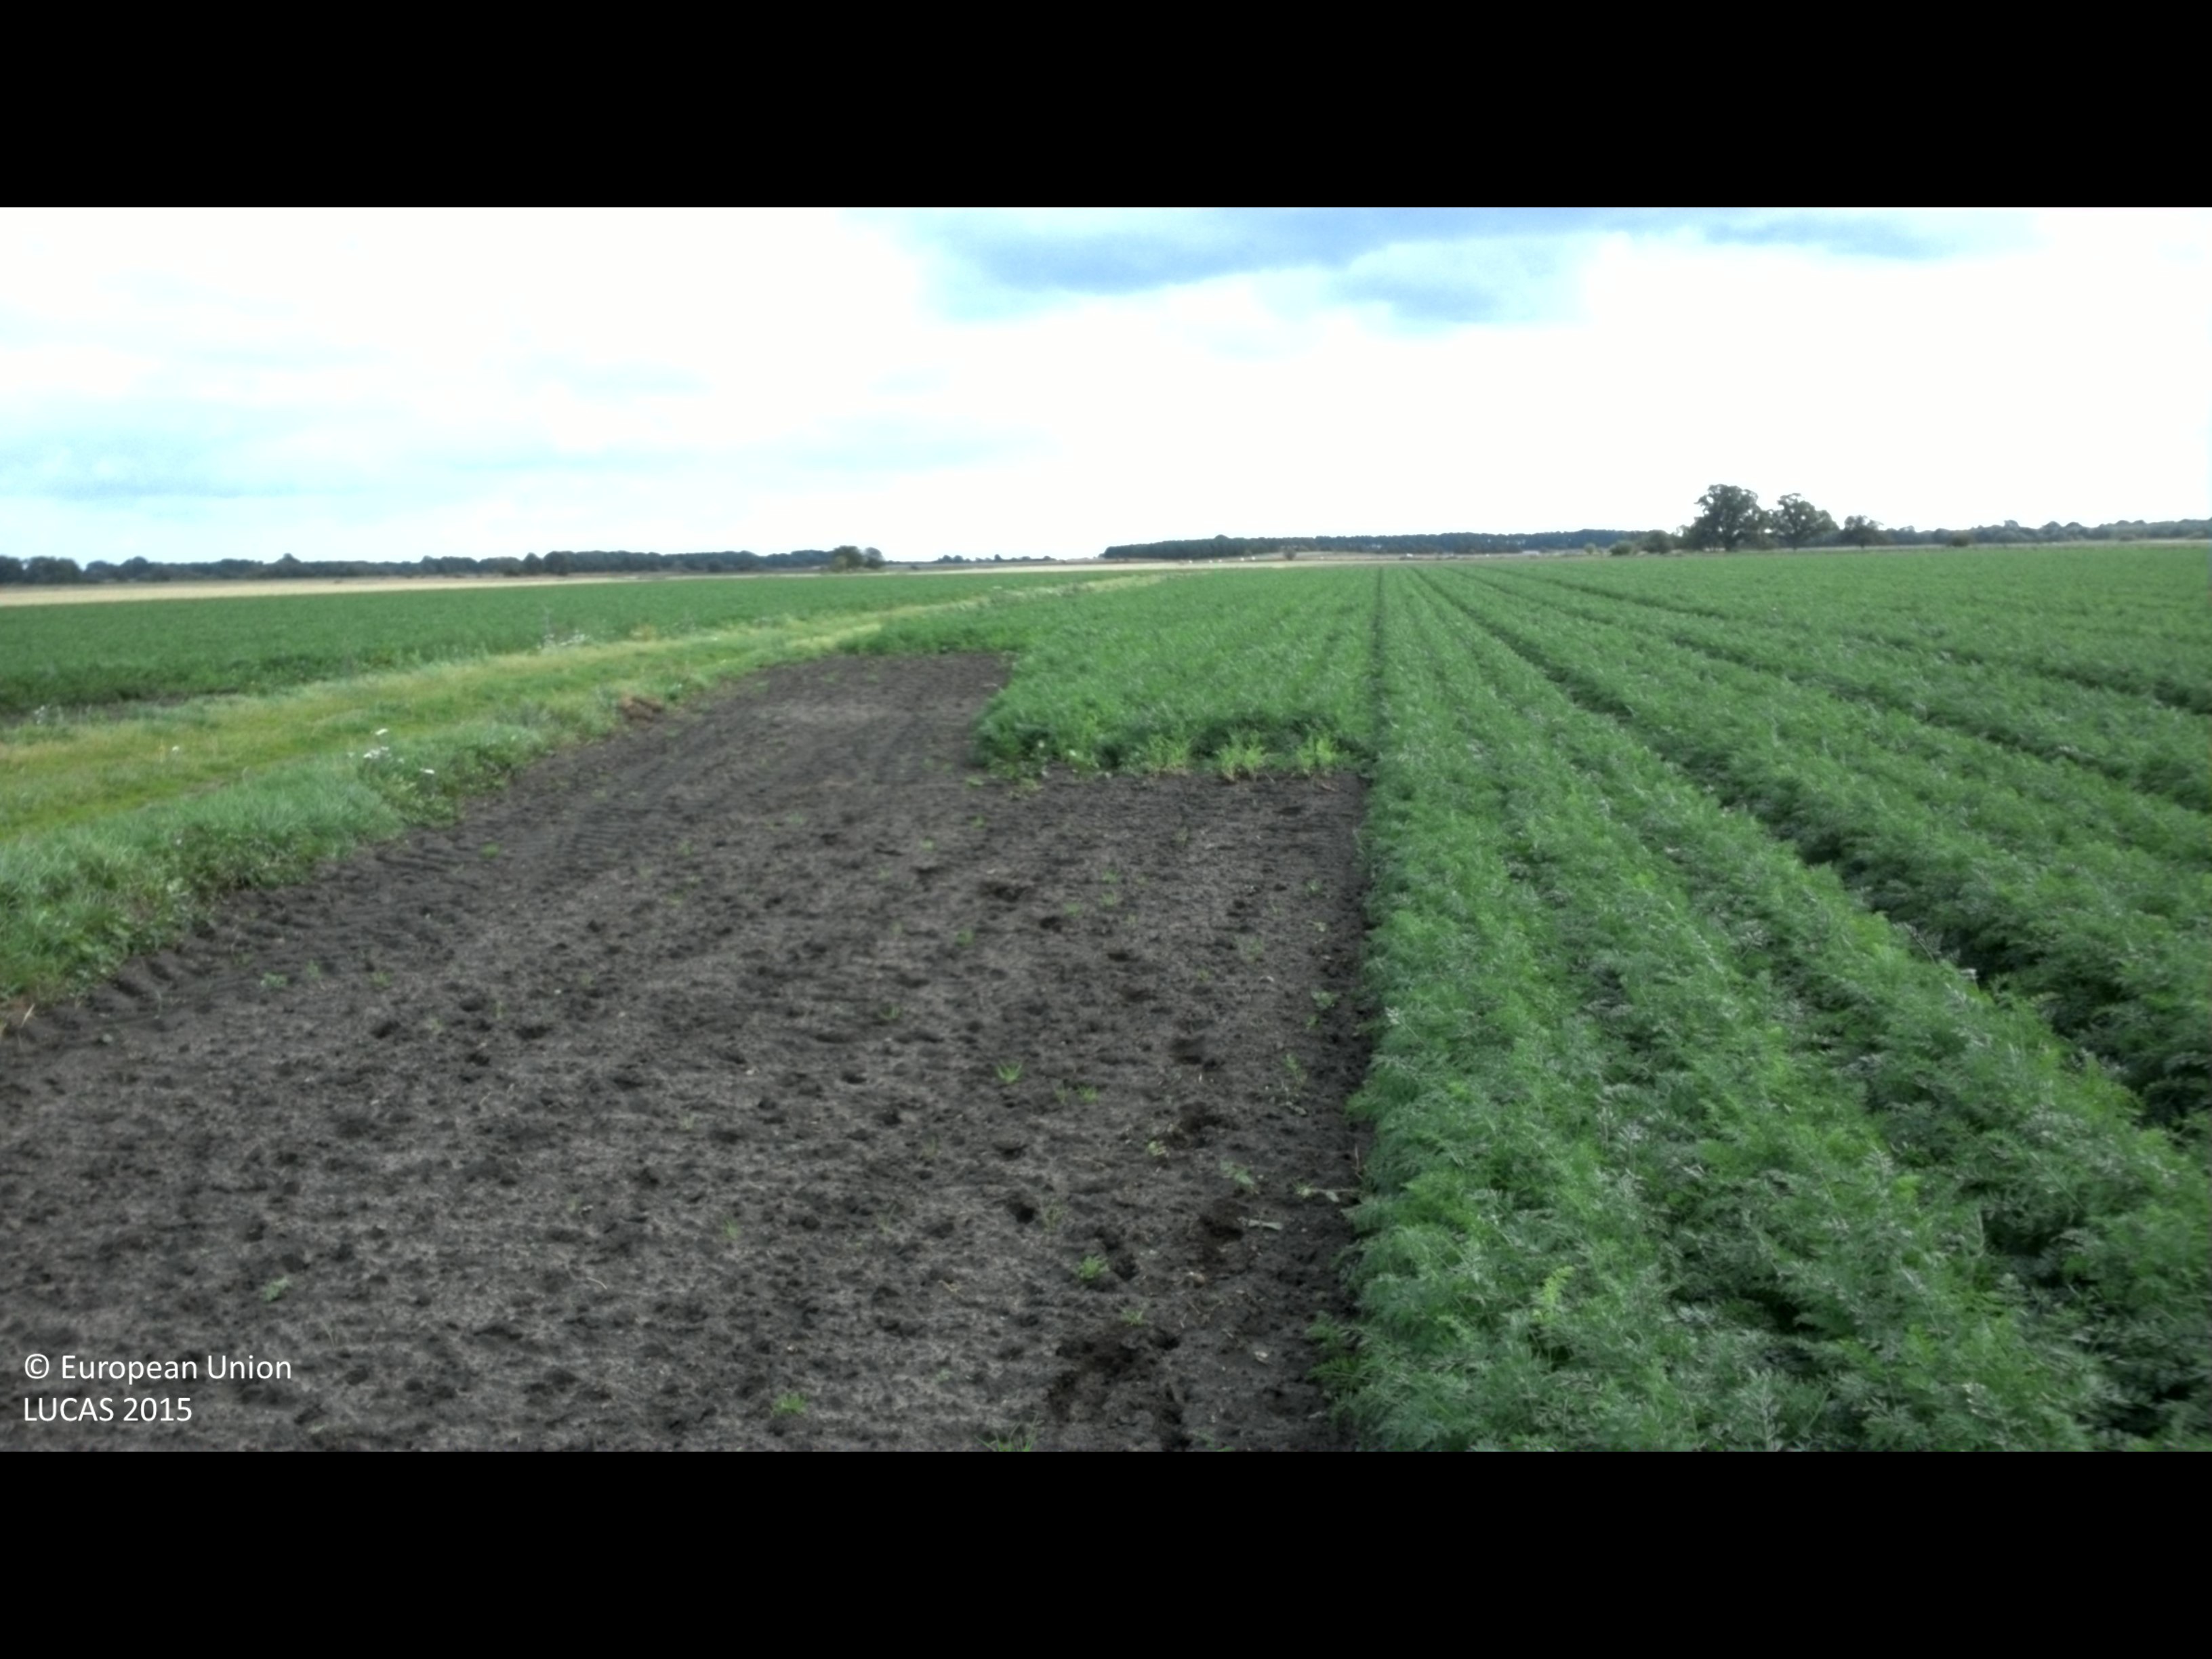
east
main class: Cropland
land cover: Other root crops
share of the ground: > 75 %
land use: Agriculture (excluding fallow land and kitchen gardens)
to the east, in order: Other root crops; Grass margins; Tracks; Grass margins; Other root crops
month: September
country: SE
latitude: 56.0220
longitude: 14.4102
